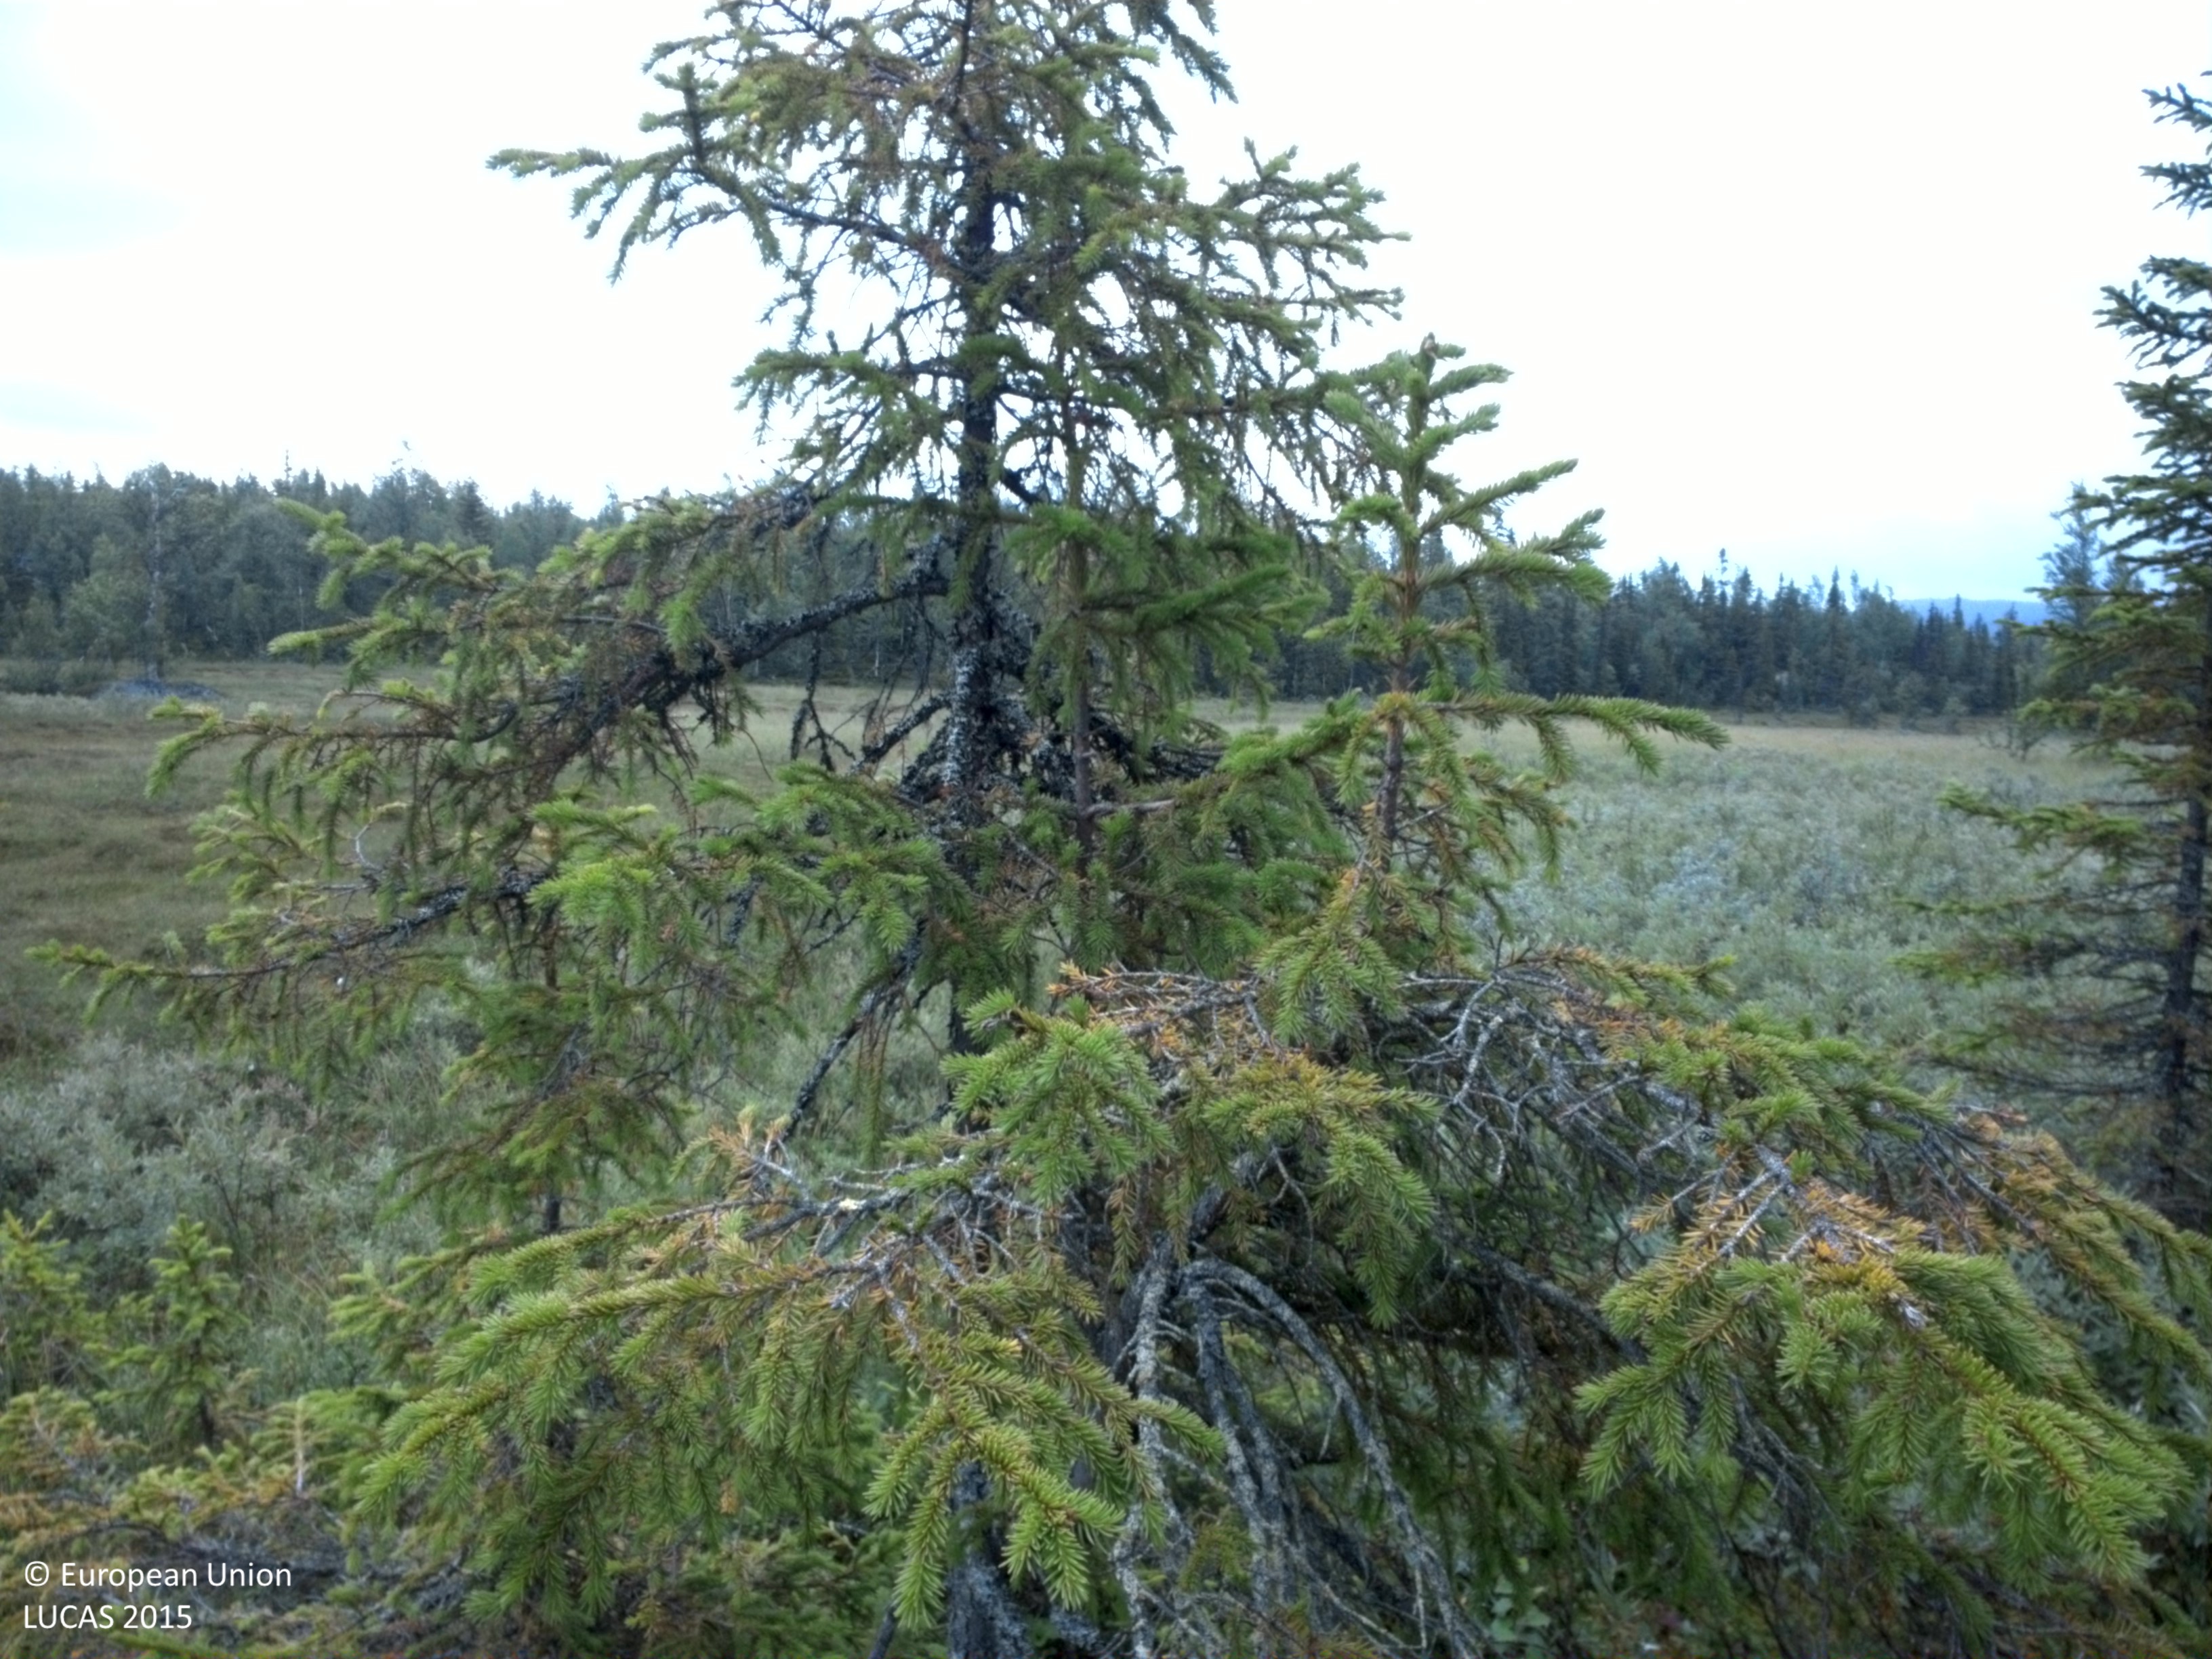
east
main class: Shrubland
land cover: Shrubland with sparse tree cover
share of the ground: > 75 %
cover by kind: shrubs 75 %, herbaceous plants 10 %, lichens and mosses 10 %, coniferous forest trees 5 %
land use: Semi-natural and natural areas not in use
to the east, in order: Shrubland with sparse tree cover; Shrubland without tree cover; Peatbogs; Electric lines; Peatbogs; Spruce dominated mixed woodland
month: August
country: SE
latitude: 64.9909
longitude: 15.5005
